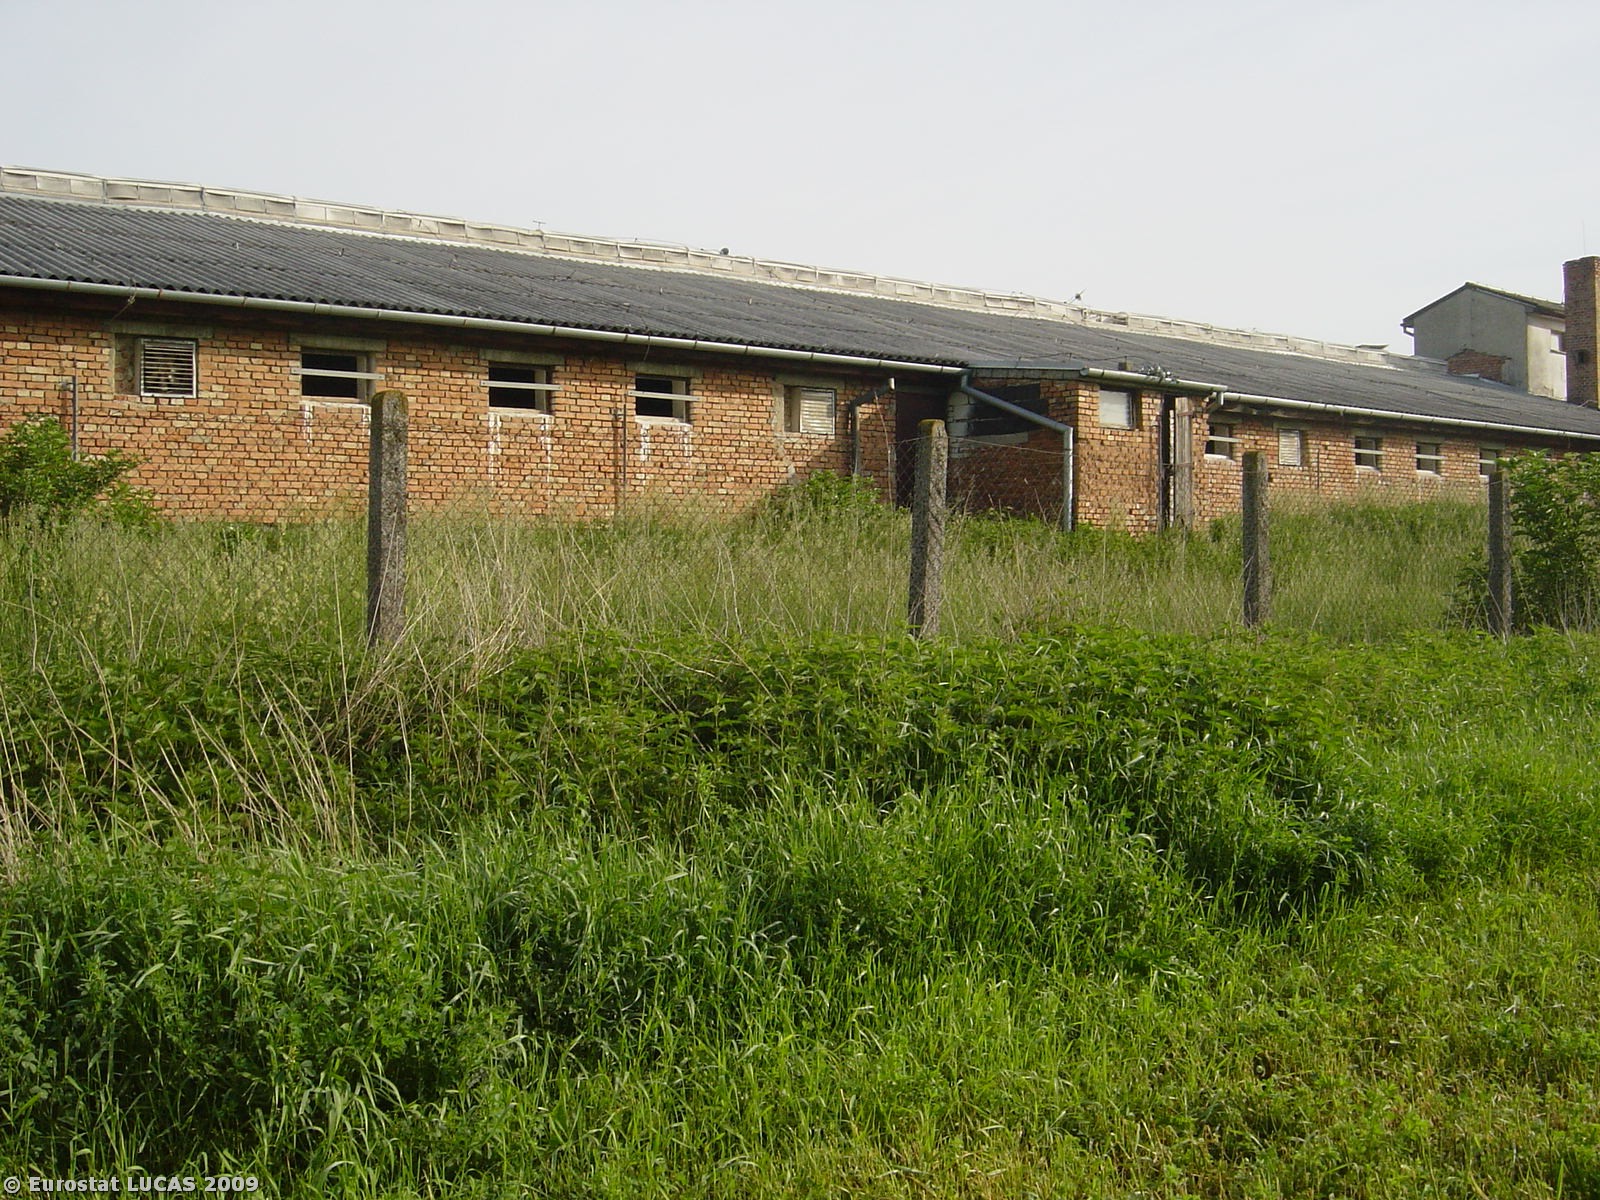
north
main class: Cropland
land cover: Lucerne
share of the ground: 25 - 50 %
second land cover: Grassland without tree/shrub cover
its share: > 75 %
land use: Agriculture (excluding fallow land and kitchen gardens)
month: May
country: CZ
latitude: 49.1701
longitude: 17.0730
